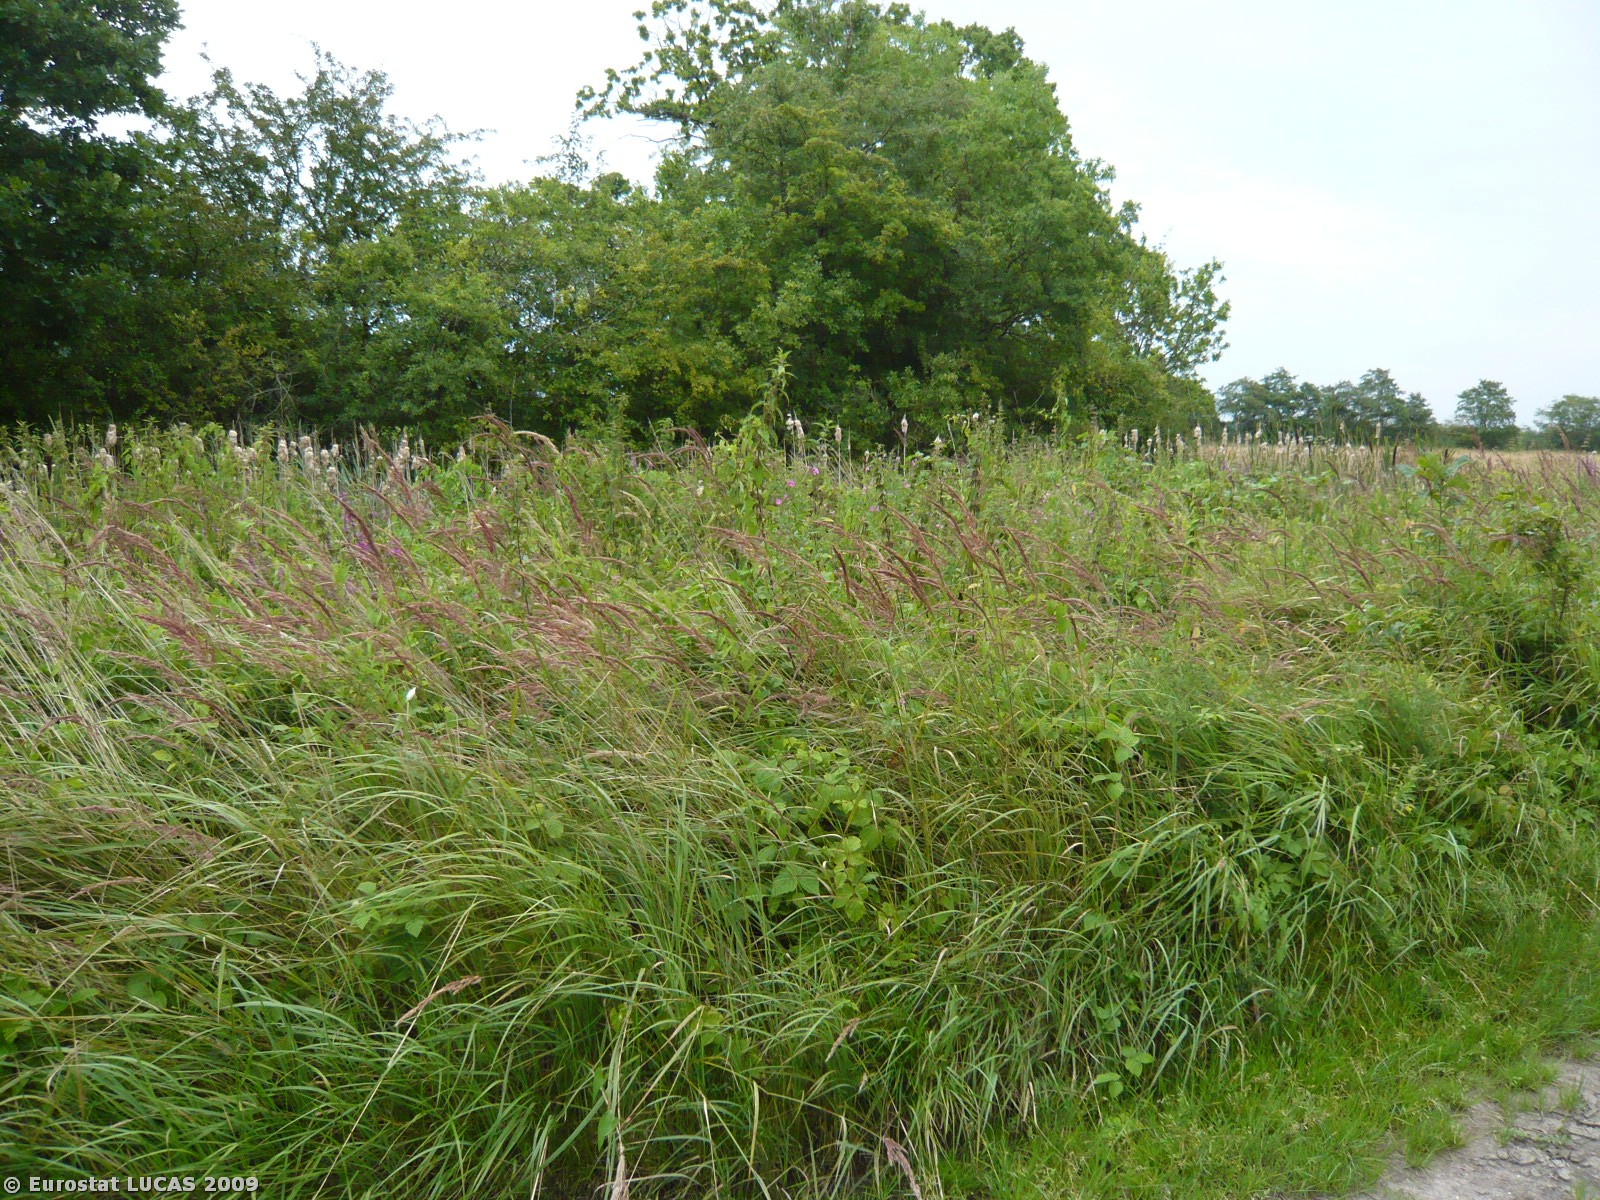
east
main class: Woodland
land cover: Broadleaved woodland
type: mesophytic deciduous forest
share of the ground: > 75 %
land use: Amenities, museums, leisure
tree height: > 5 m
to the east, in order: Broadleaved woodland; Grassland without tree/shrub cover
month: August
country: DK
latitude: 55.9574
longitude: 11.9362
